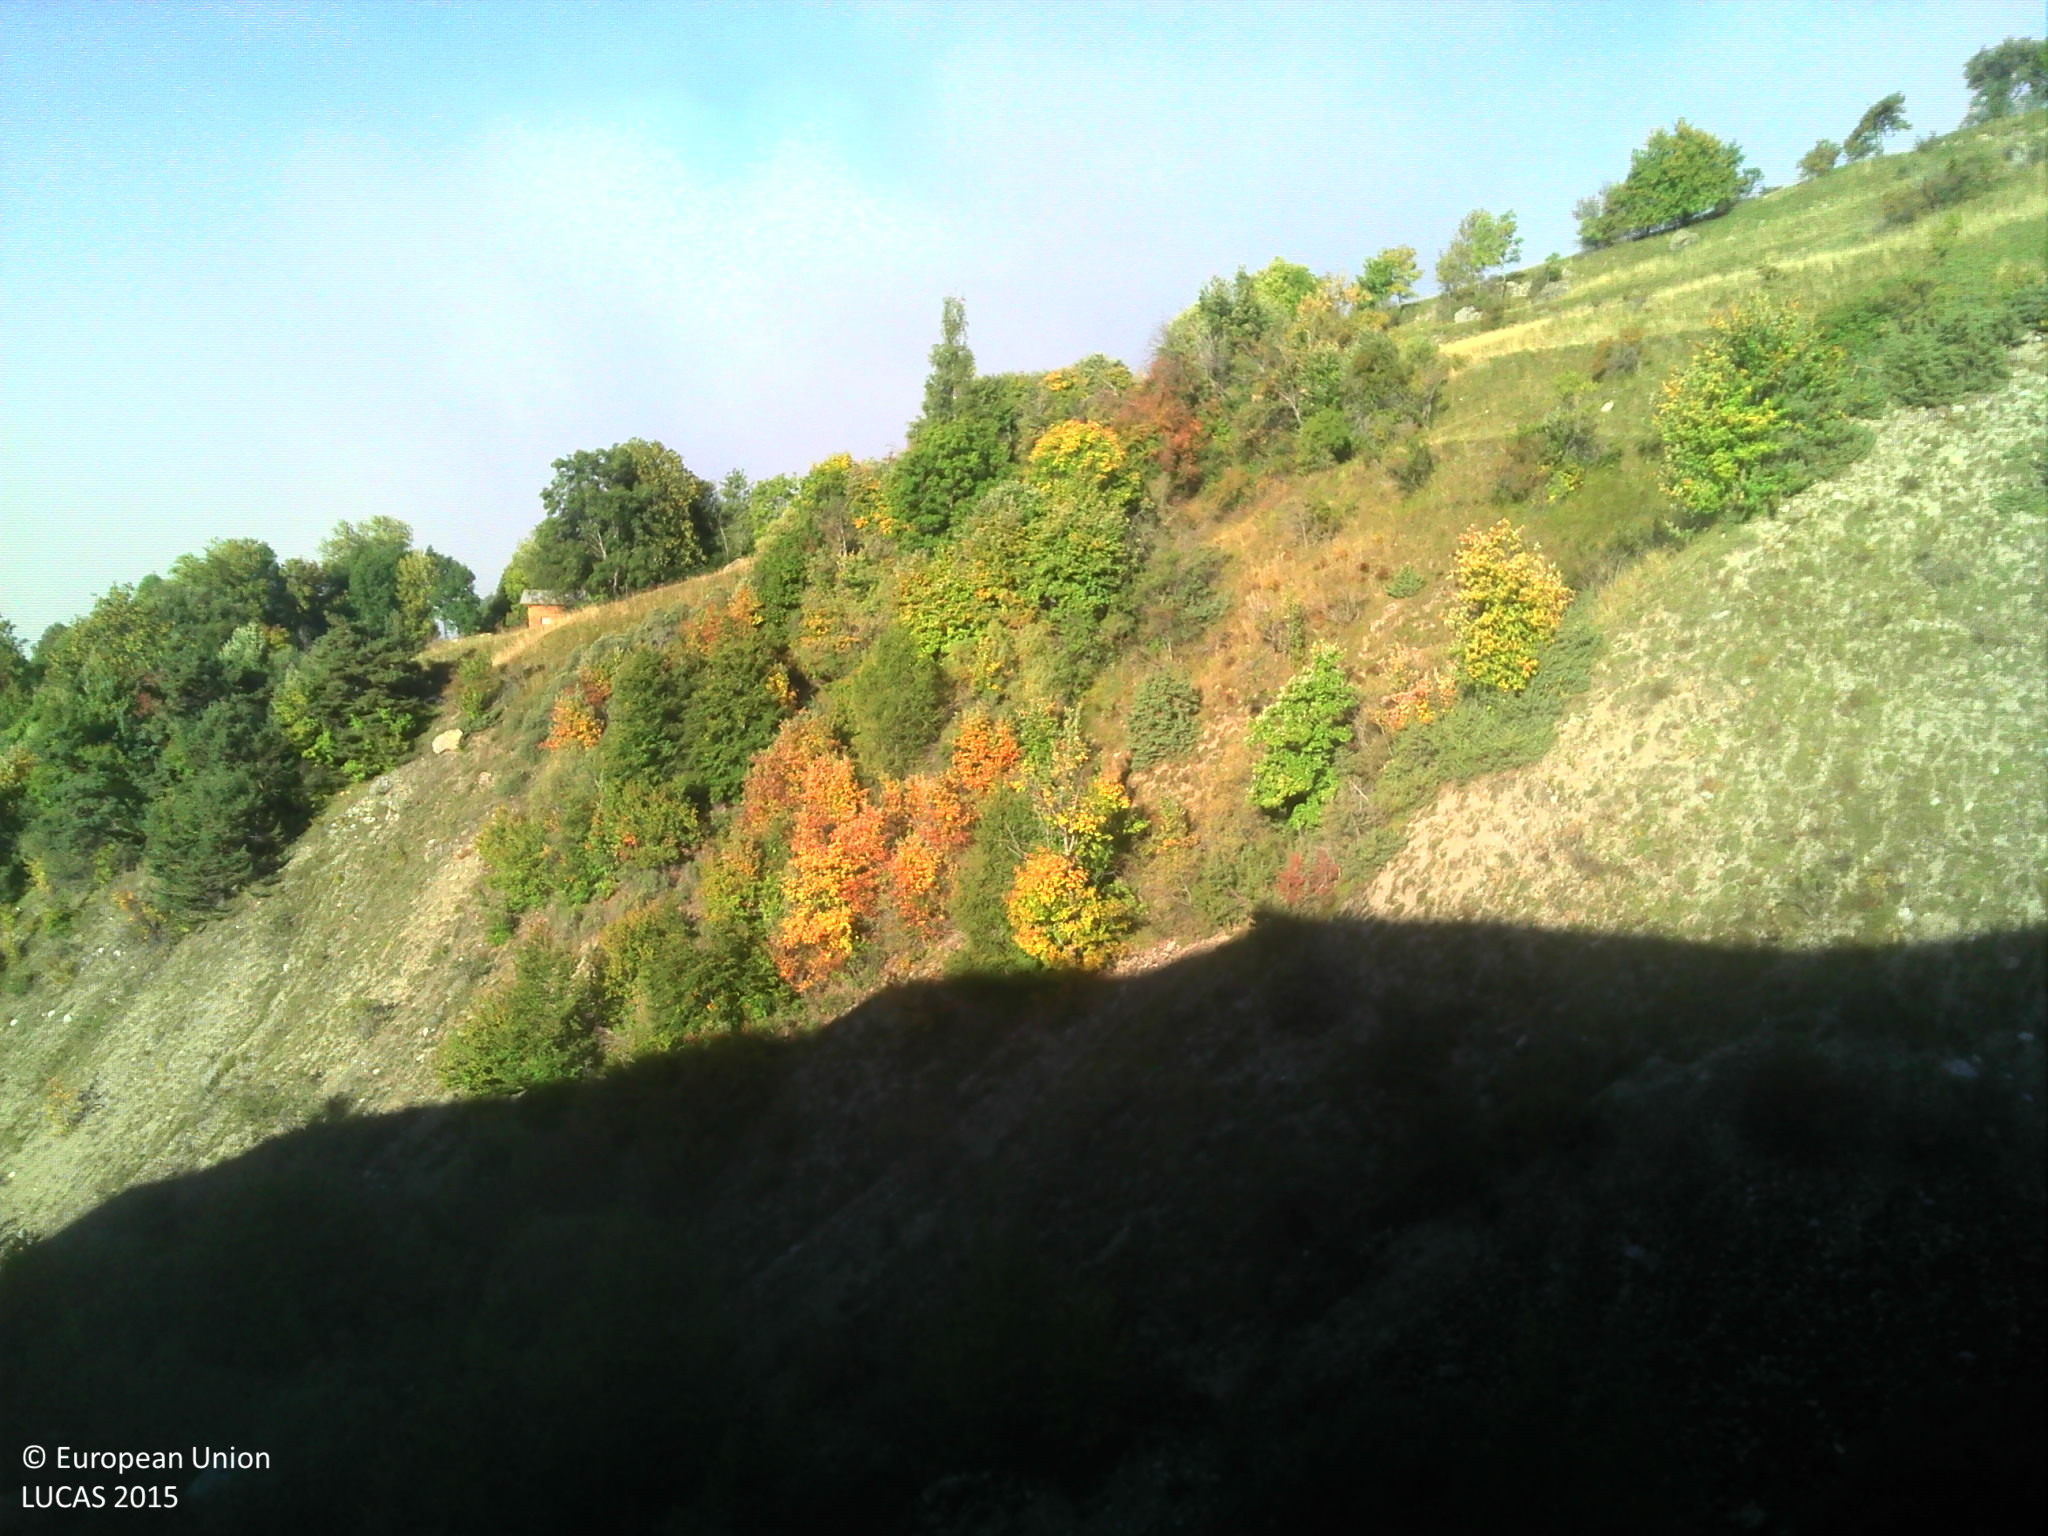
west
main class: Grassland
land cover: Spontaneously vegetated surfaces
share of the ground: 25 - 50 %
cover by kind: consolidated bare surface 60 %, herbaceous plants 40 %
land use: Semi-natural and natural areas not in use
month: September
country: FR
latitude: 44.6254
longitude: 6.2378
